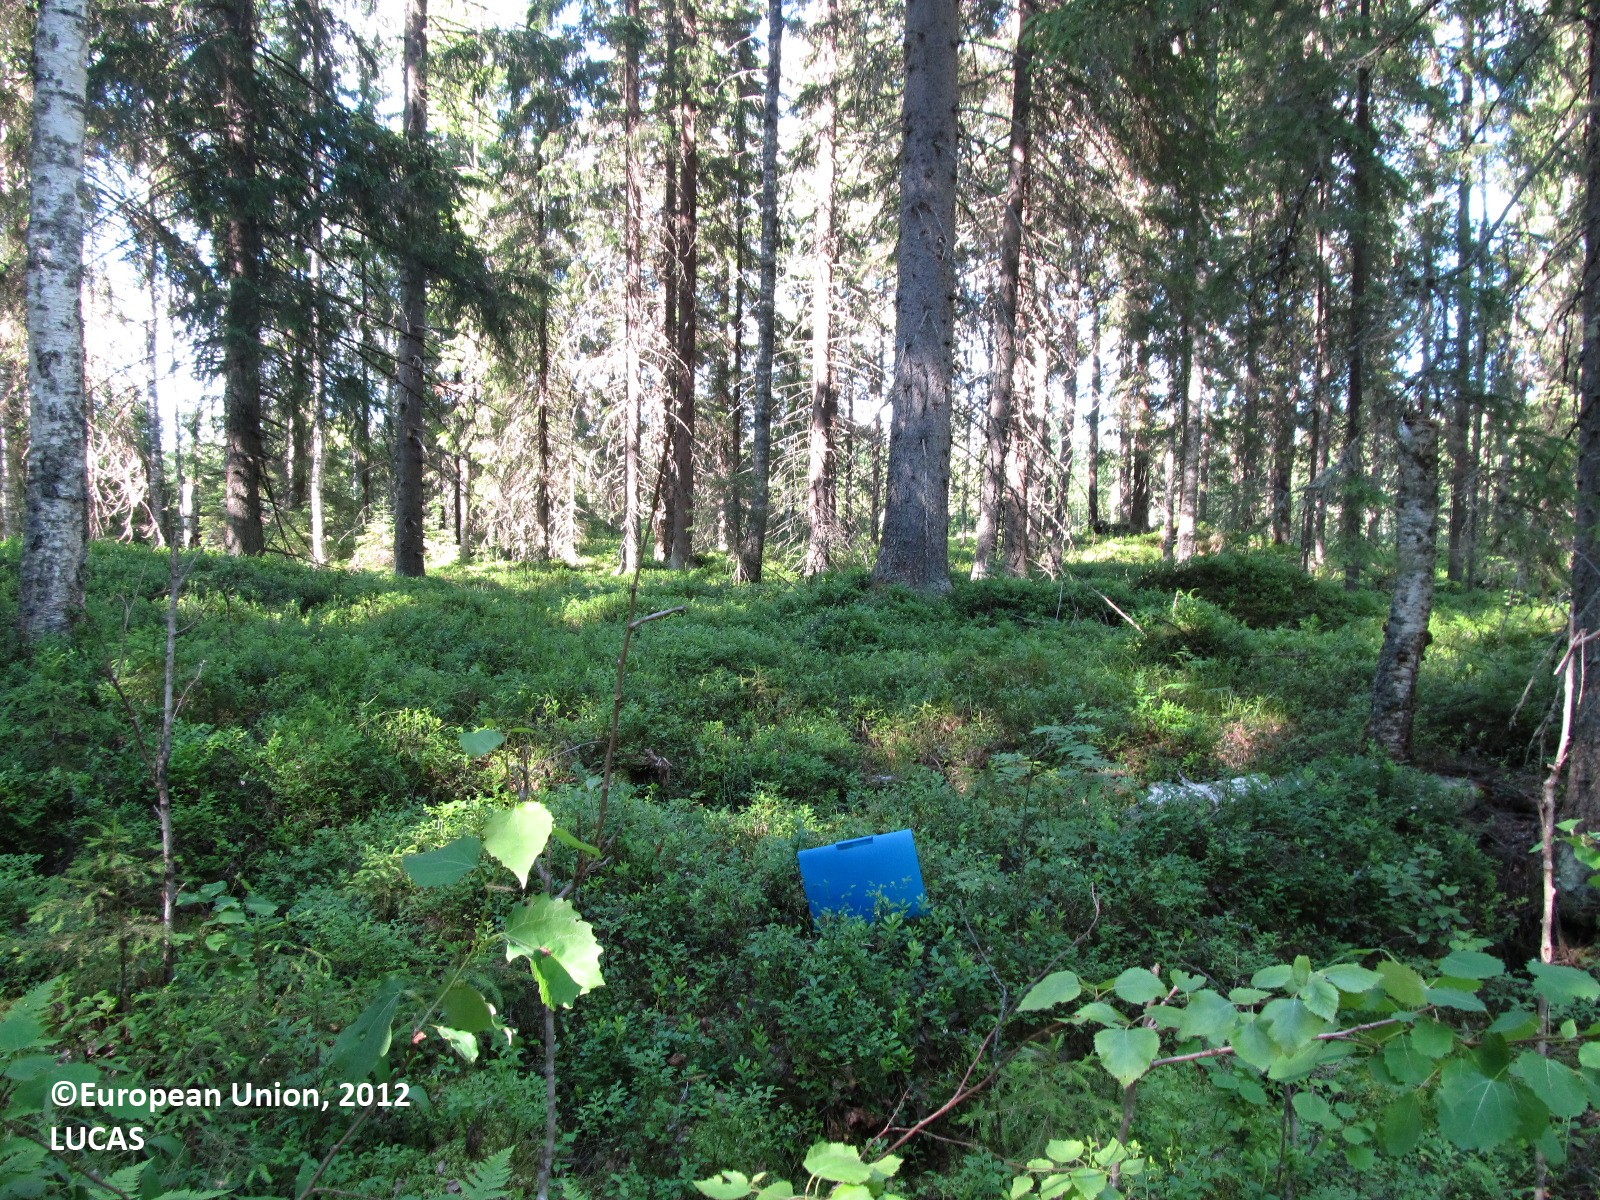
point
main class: Woodland
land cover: Spruce dominated coniferous woodland
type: boreal forest
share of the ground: 50 - 75 %
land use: Forestry
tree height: > 5 m
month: July
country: FI
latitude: 62.5603
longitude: 28.9897
